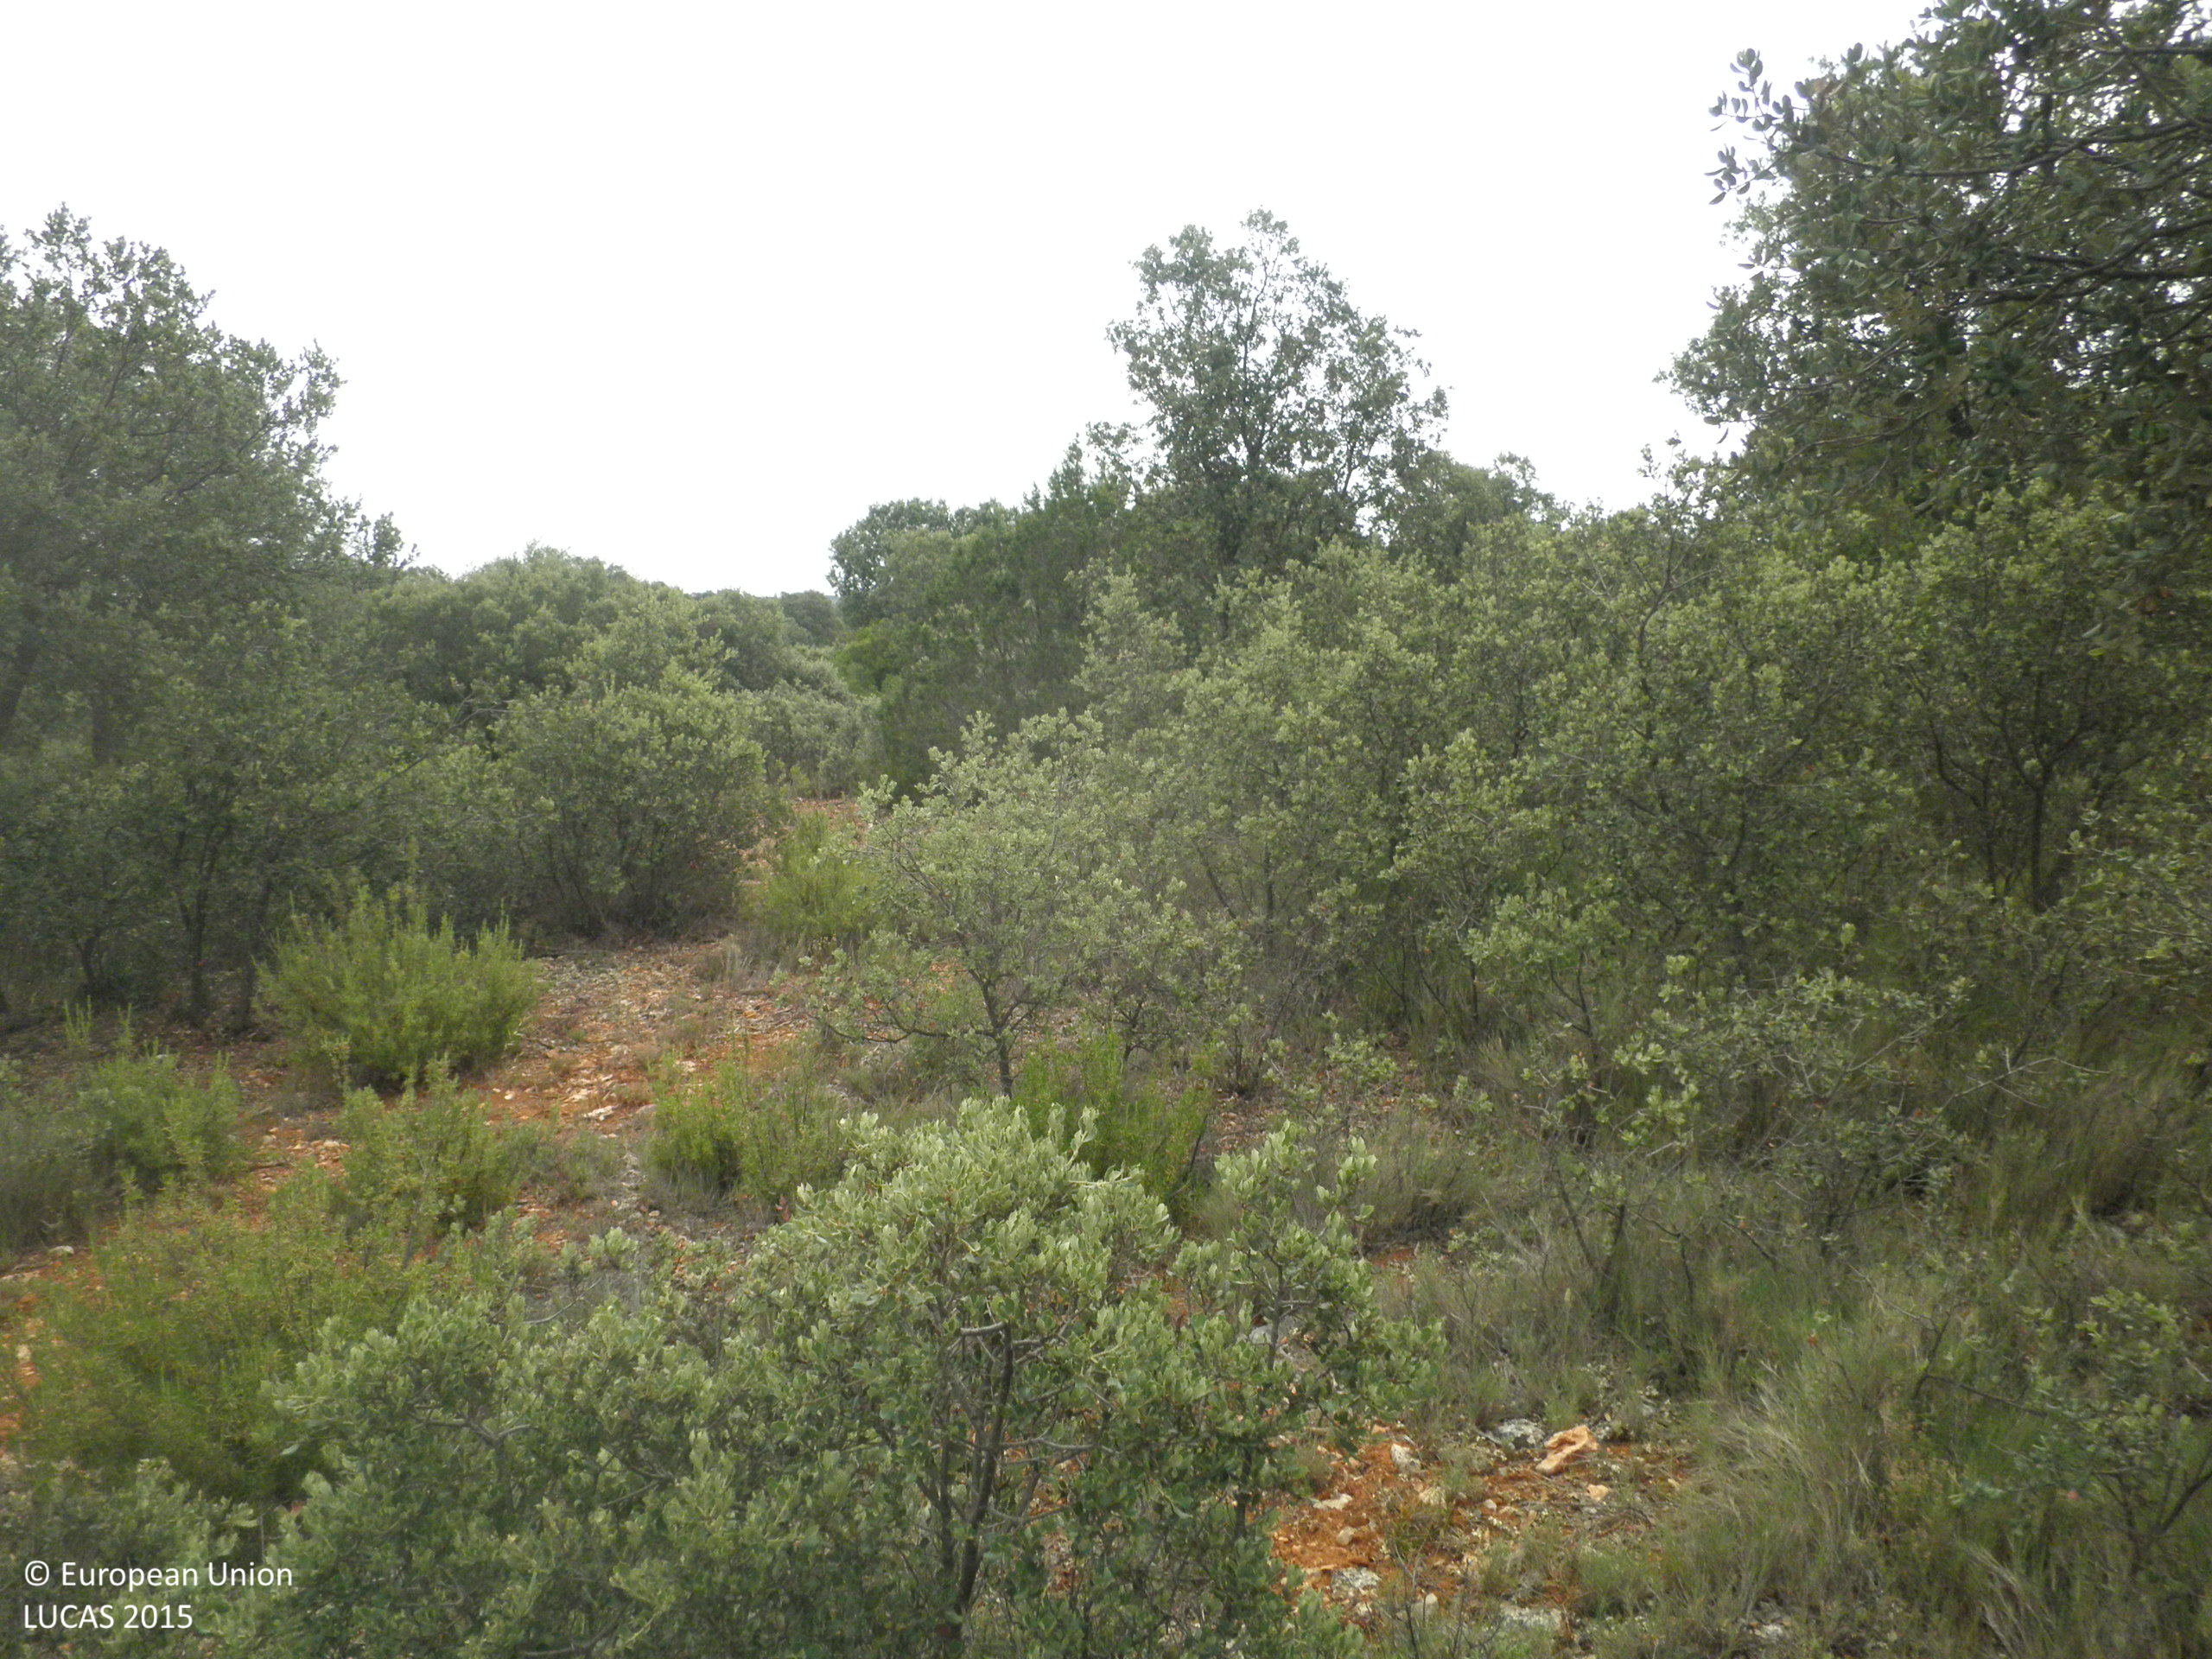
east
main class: Woodland
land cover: Broadleaved woodland
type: broadleaved evergreen forest
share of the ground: 25 - 50 %
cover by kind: shrubs 35 %, unconsolidated bare surface 30 %, broadleaved forest trees 25 %, herbaceous plants 10 %
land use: Semi-natural and natural areas not in use
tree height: < 5 m
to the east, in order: Broadleaved woodland; Tracks; Broadleaved woodland
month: June
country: ES
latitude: 39.5642
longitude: -1.7041
